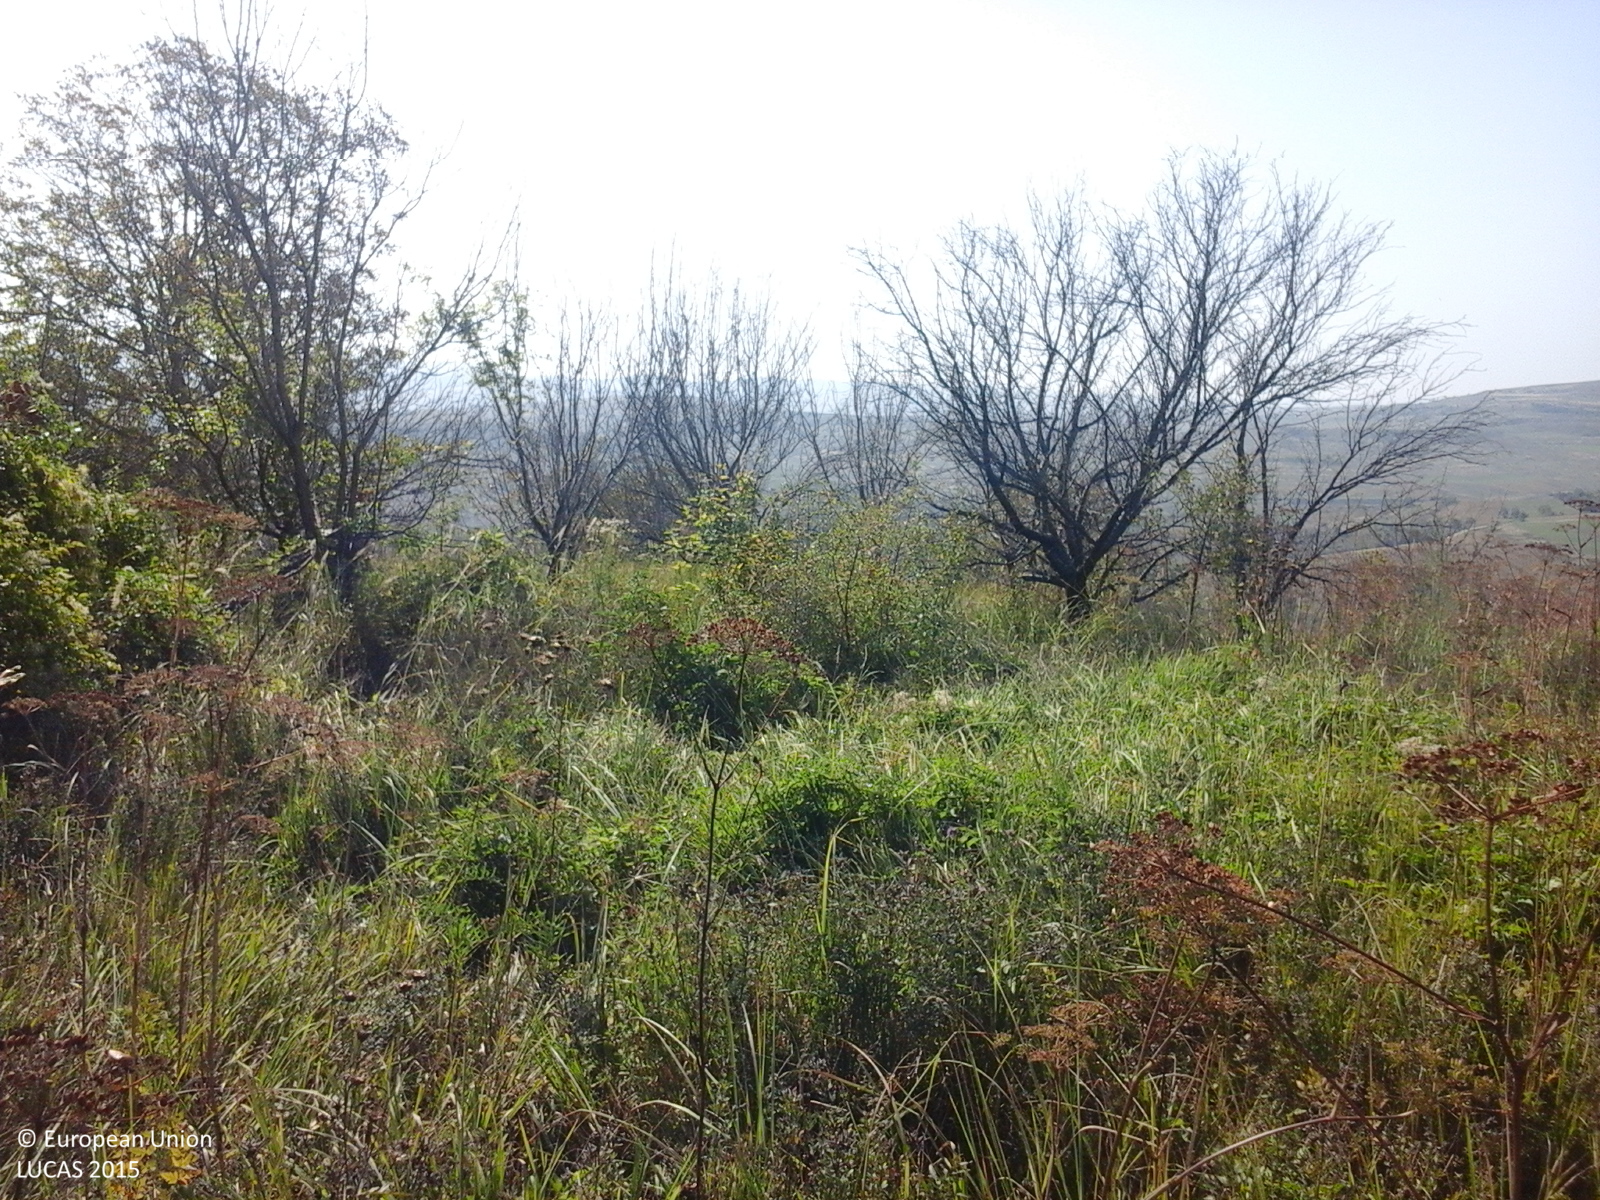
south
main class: Grassland
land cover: Grassland without tree/shrub cover
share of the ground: > 75 %
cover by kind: herbaceous plants 100 %
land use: Agriculture (excluding fallow land and kitchen gardens)
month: September
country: RO
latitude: 46.9380
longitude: 23.8834
